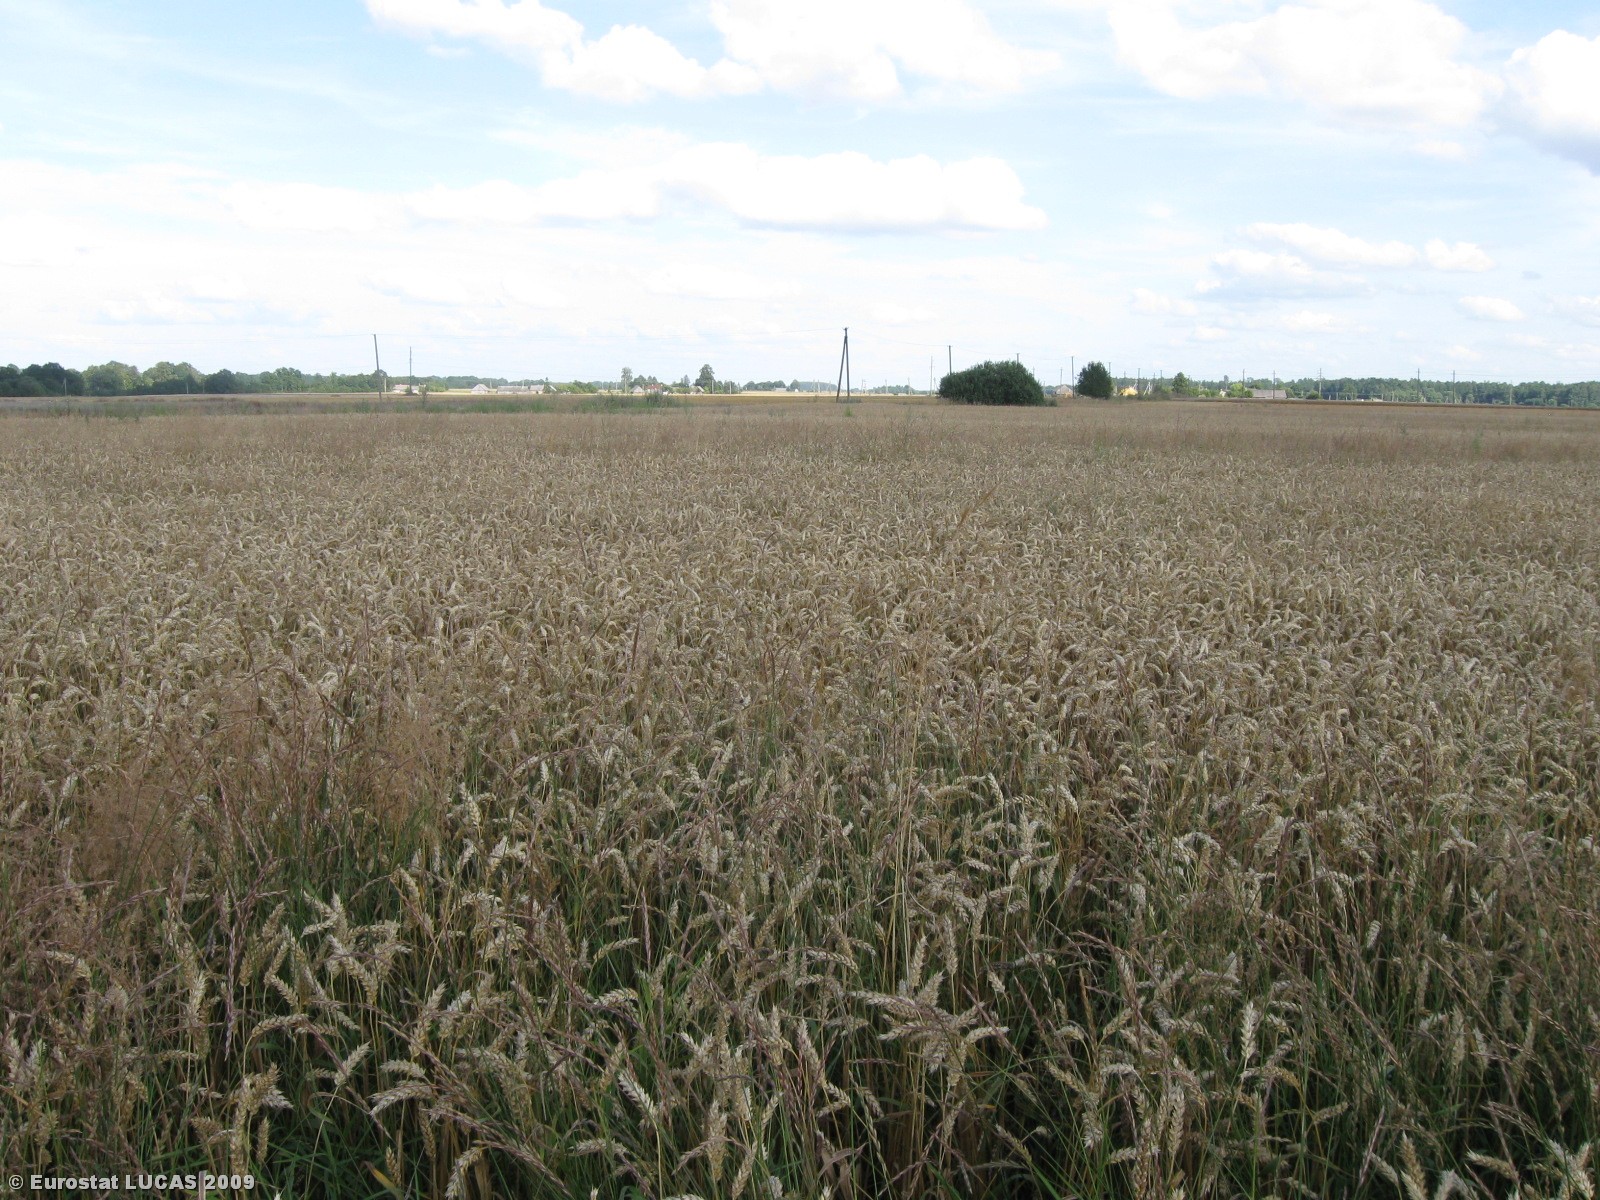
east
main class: Cropland
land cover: Common wheat
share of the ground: > 75 %
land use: Agriculture (excluding fallow land and kitchen gardens)
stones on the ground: < 10 %
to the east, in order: Common wheat; Grass margins; Tracks; Bare land; Tracks; Bare land; Electric lines; Bare land; Rye
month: August
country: LT
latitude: 55.1735
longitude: 22.6728
